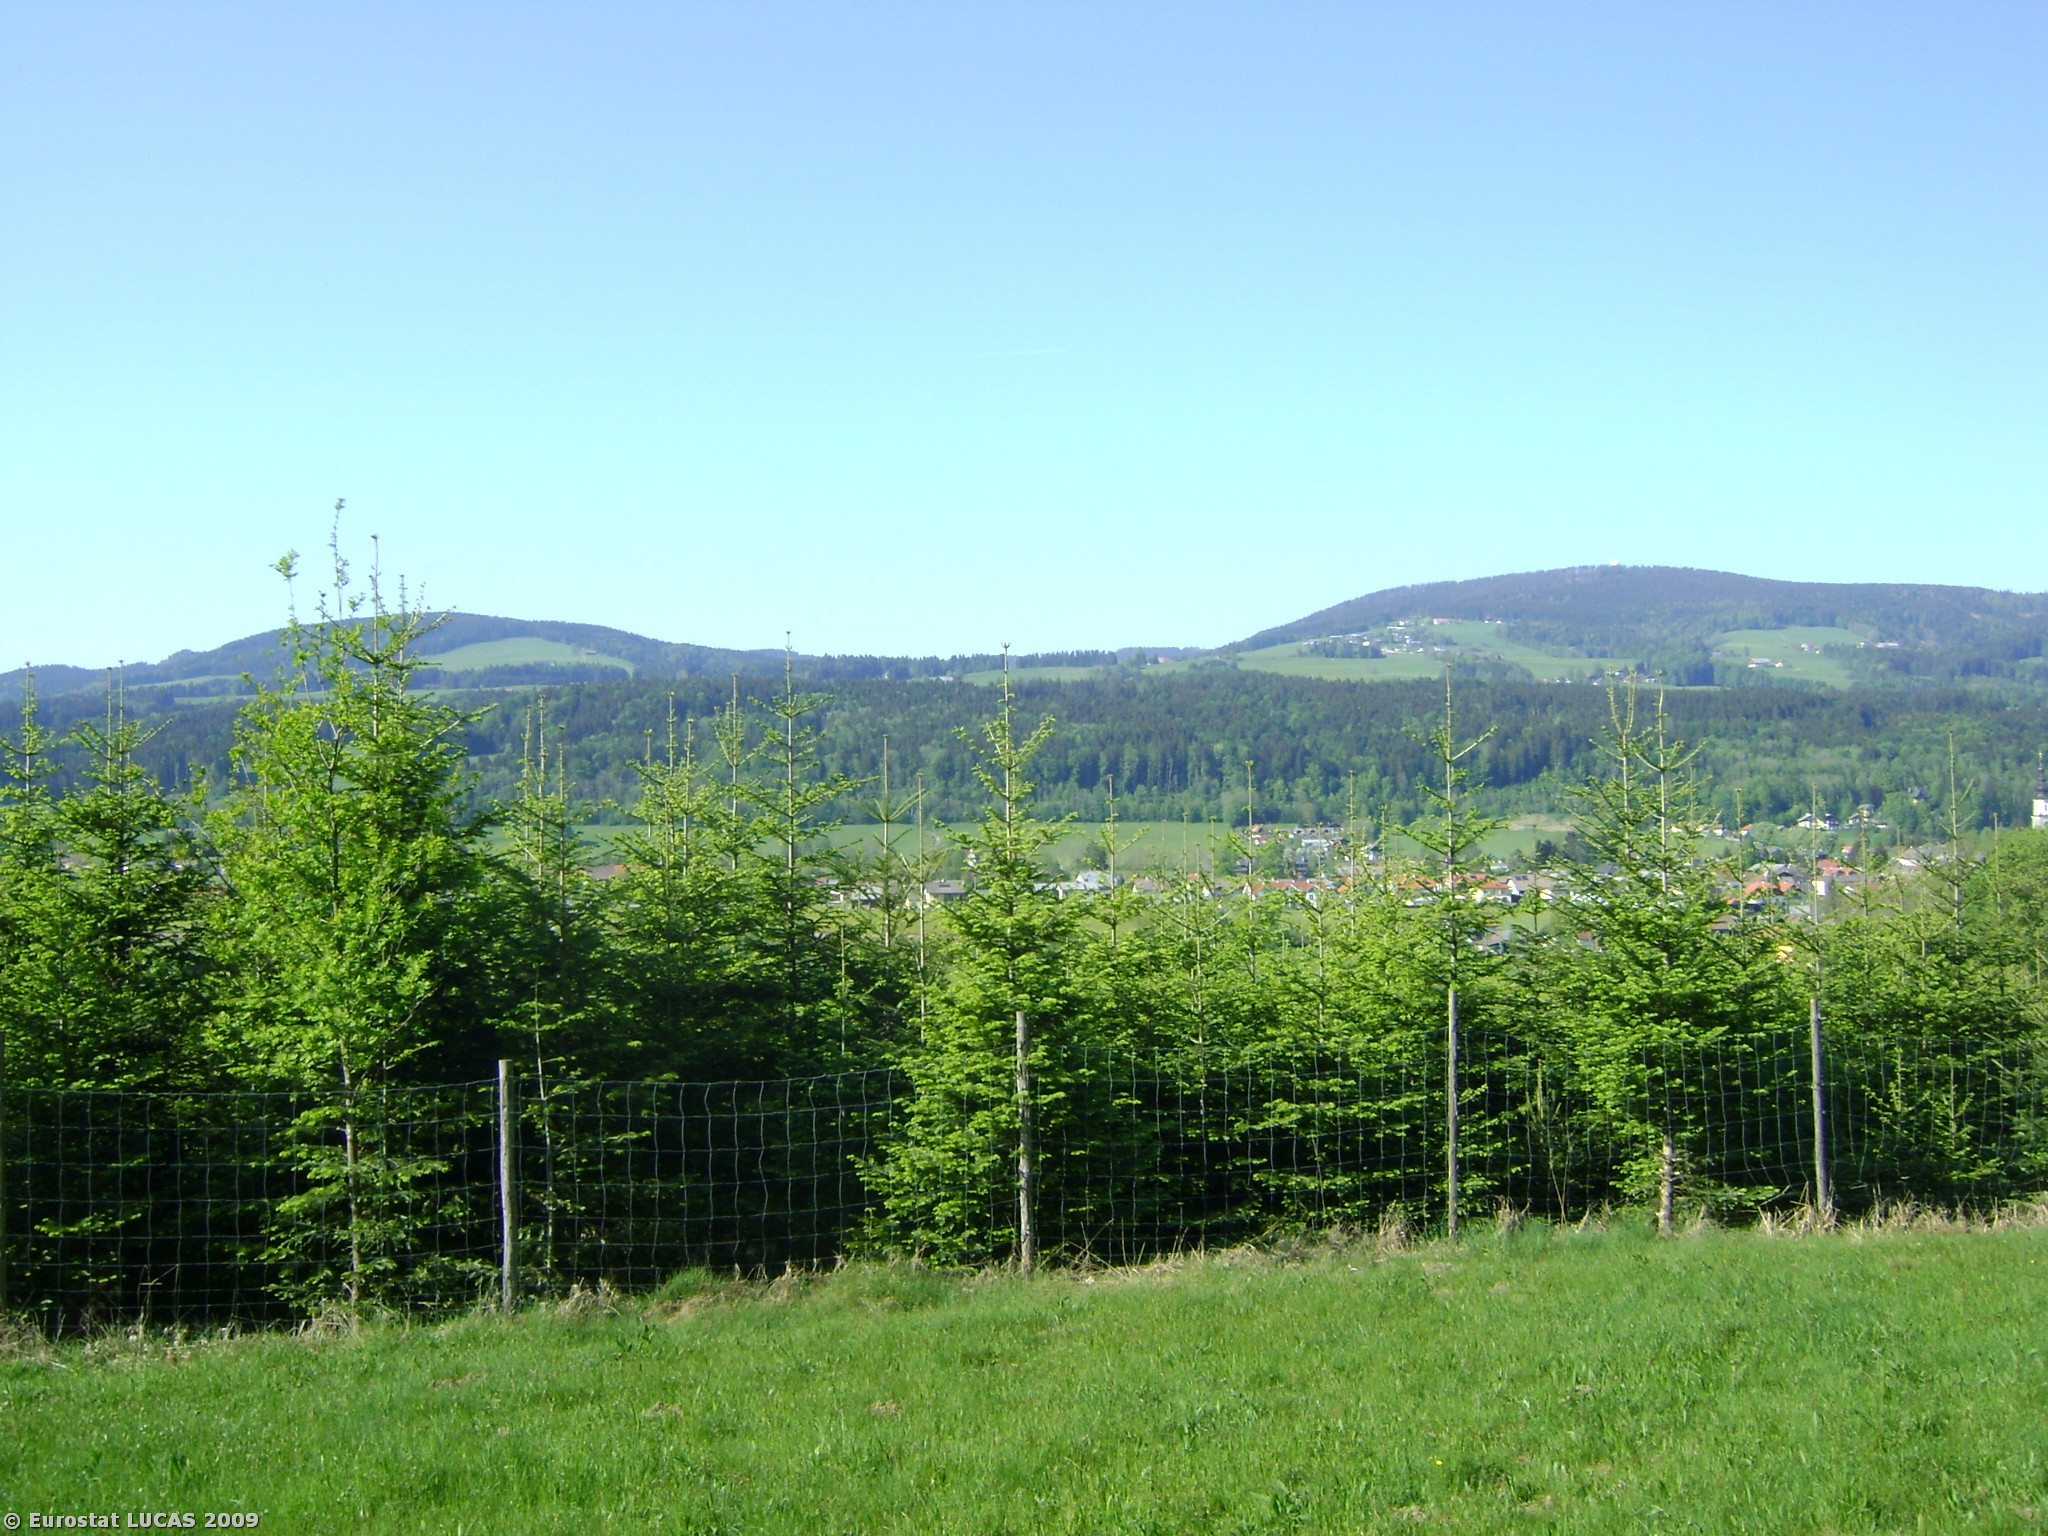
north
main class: Grassland
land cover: Grassland without tree/shrub cover
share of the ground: > 75 %
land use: Agriculture (excluding fallow land and kitchen gardens)
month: May
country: AT
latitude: 47.8336
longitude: 13.2452
